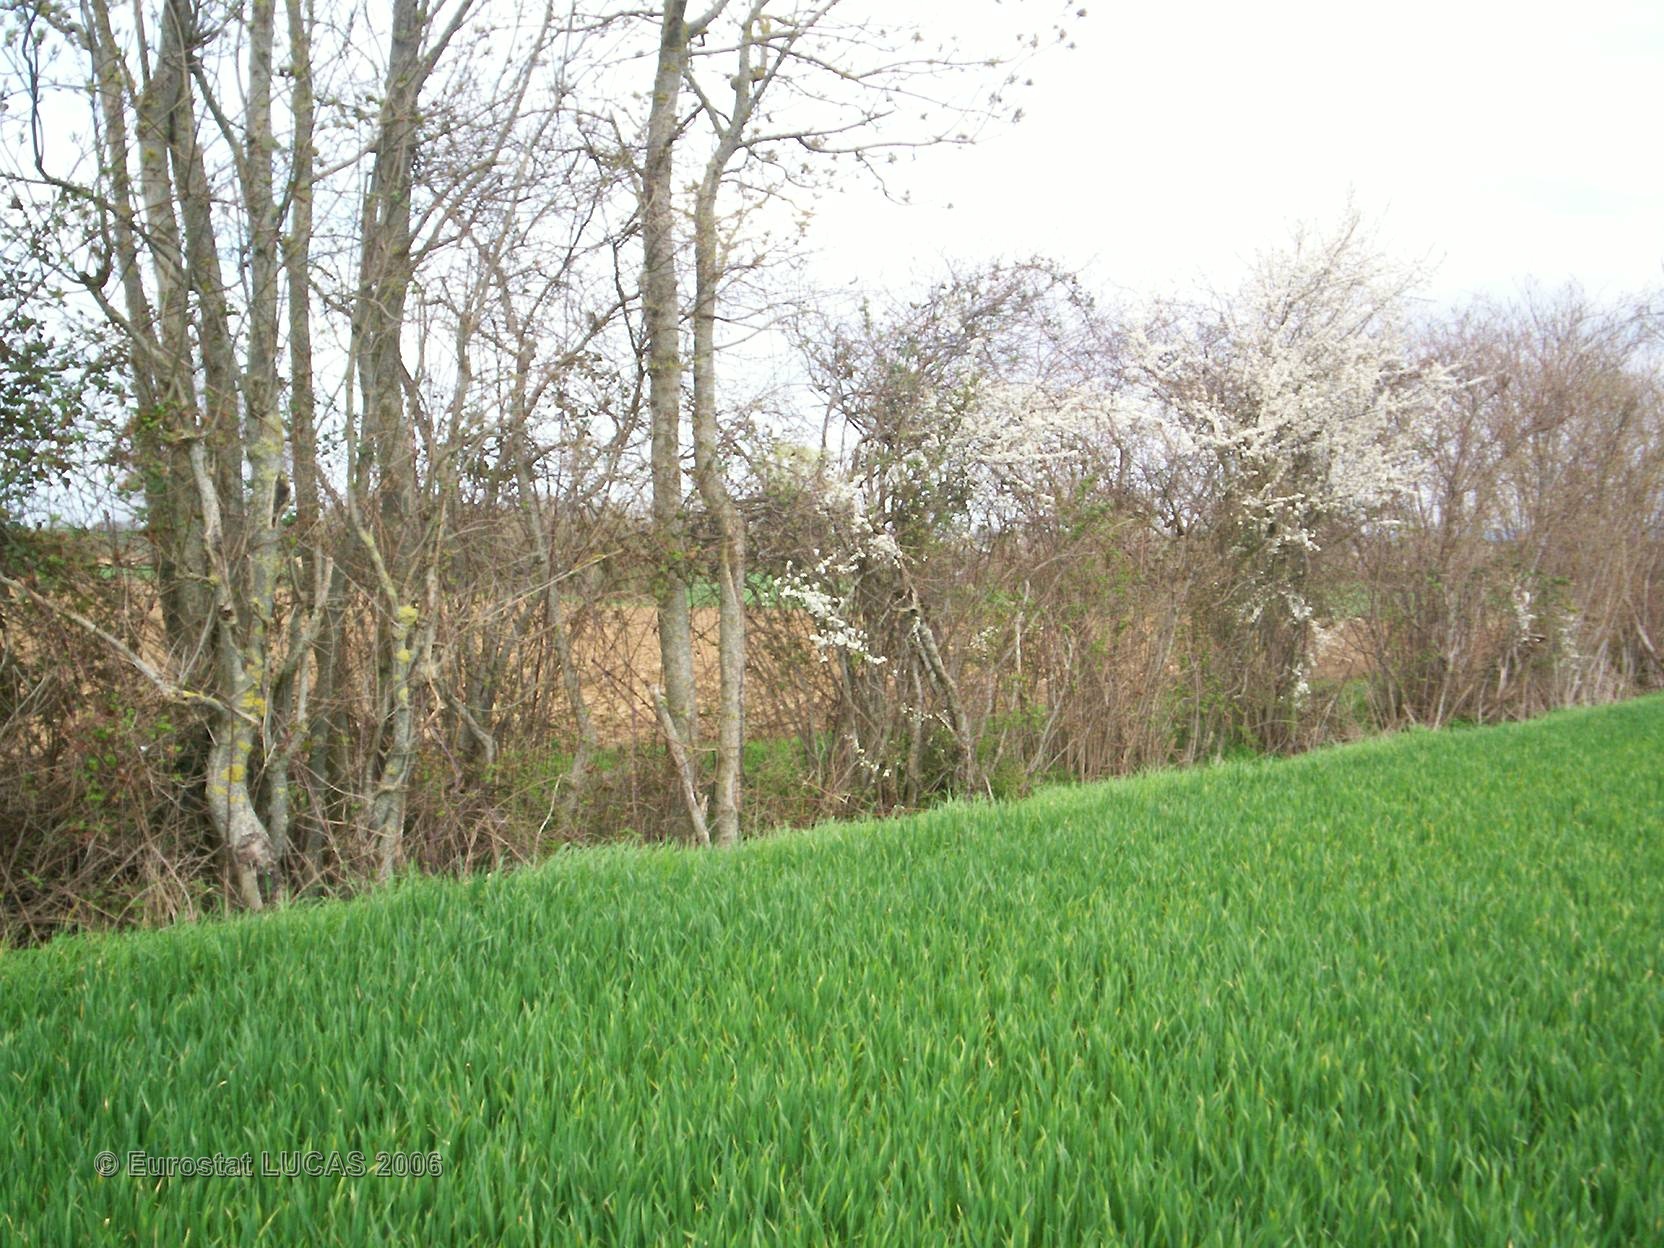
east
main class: Cropland
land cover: Common wheat
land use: Agriculture (excluding fallow land and kitchen gardens)
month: April
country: FR
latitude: 48.2696
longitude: 0.3413
